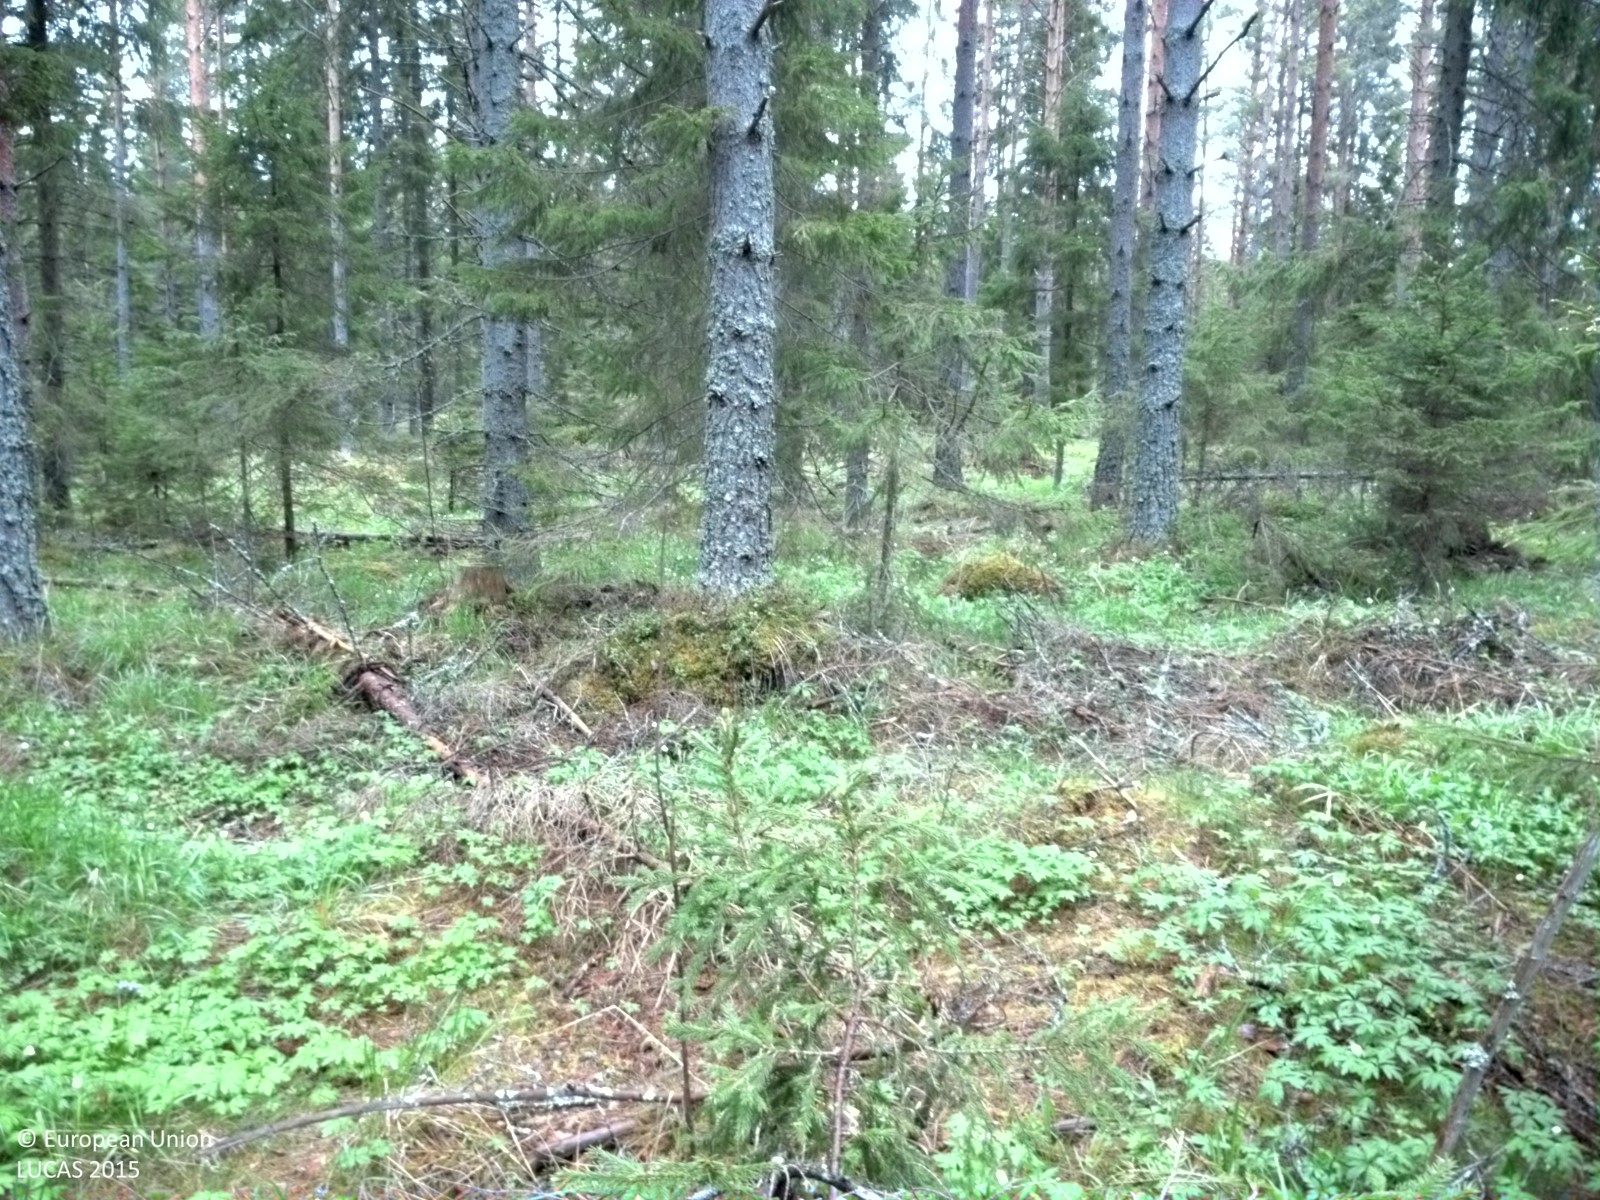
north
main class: Woodland
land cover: Spruce dominated coniferous woodland
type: boreal forest
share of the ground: 50 - 75 %
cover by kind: coniferous forest trees 55 %, herbaceous plants 25 %, shrubs 15 %, lichens and mosses 5 %
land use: Forestry
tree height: > 5 m
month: May
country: SE
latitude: 60.2392
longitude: 18.0674
